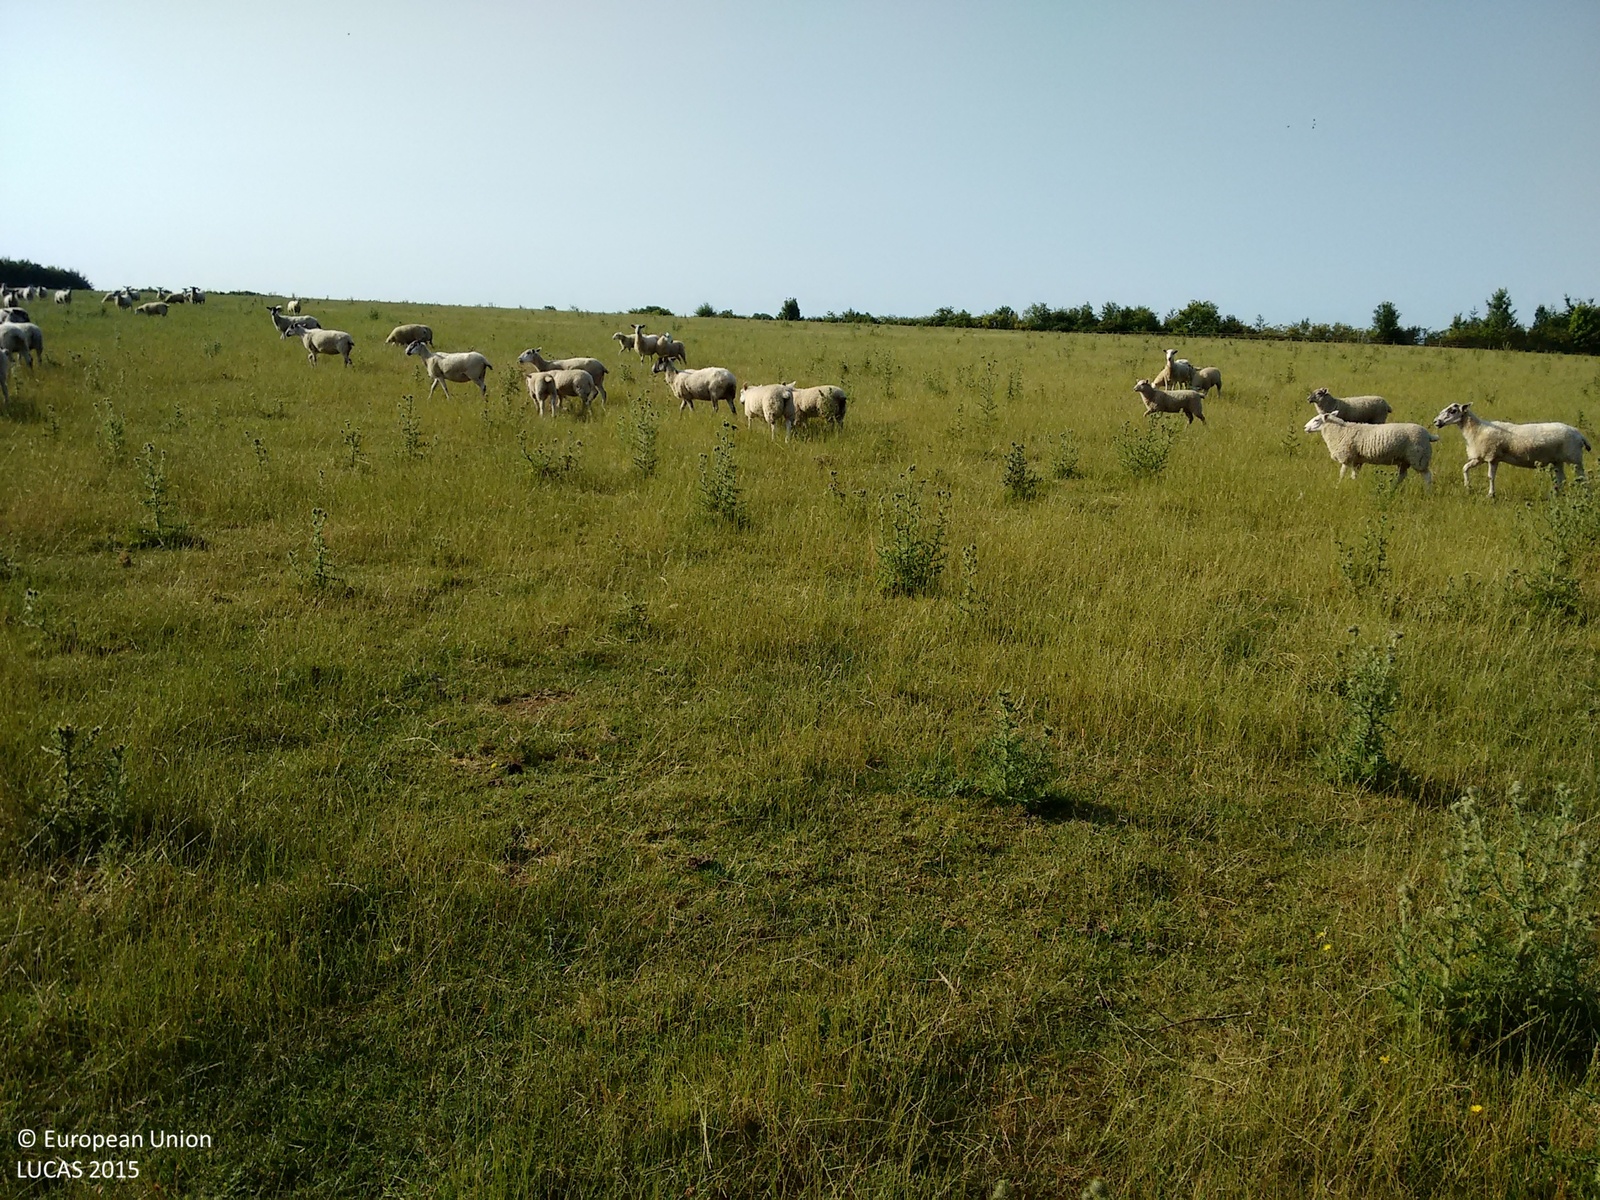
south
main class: Grassland
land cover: Grassland without tree/shrub cover
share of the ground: > 75 %
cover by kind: herbaceous plants 100 %
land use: Agriculture (excluding fallow land and kitchen gardens)
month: July
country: GB
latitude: 51.9688
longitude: -1.2409
